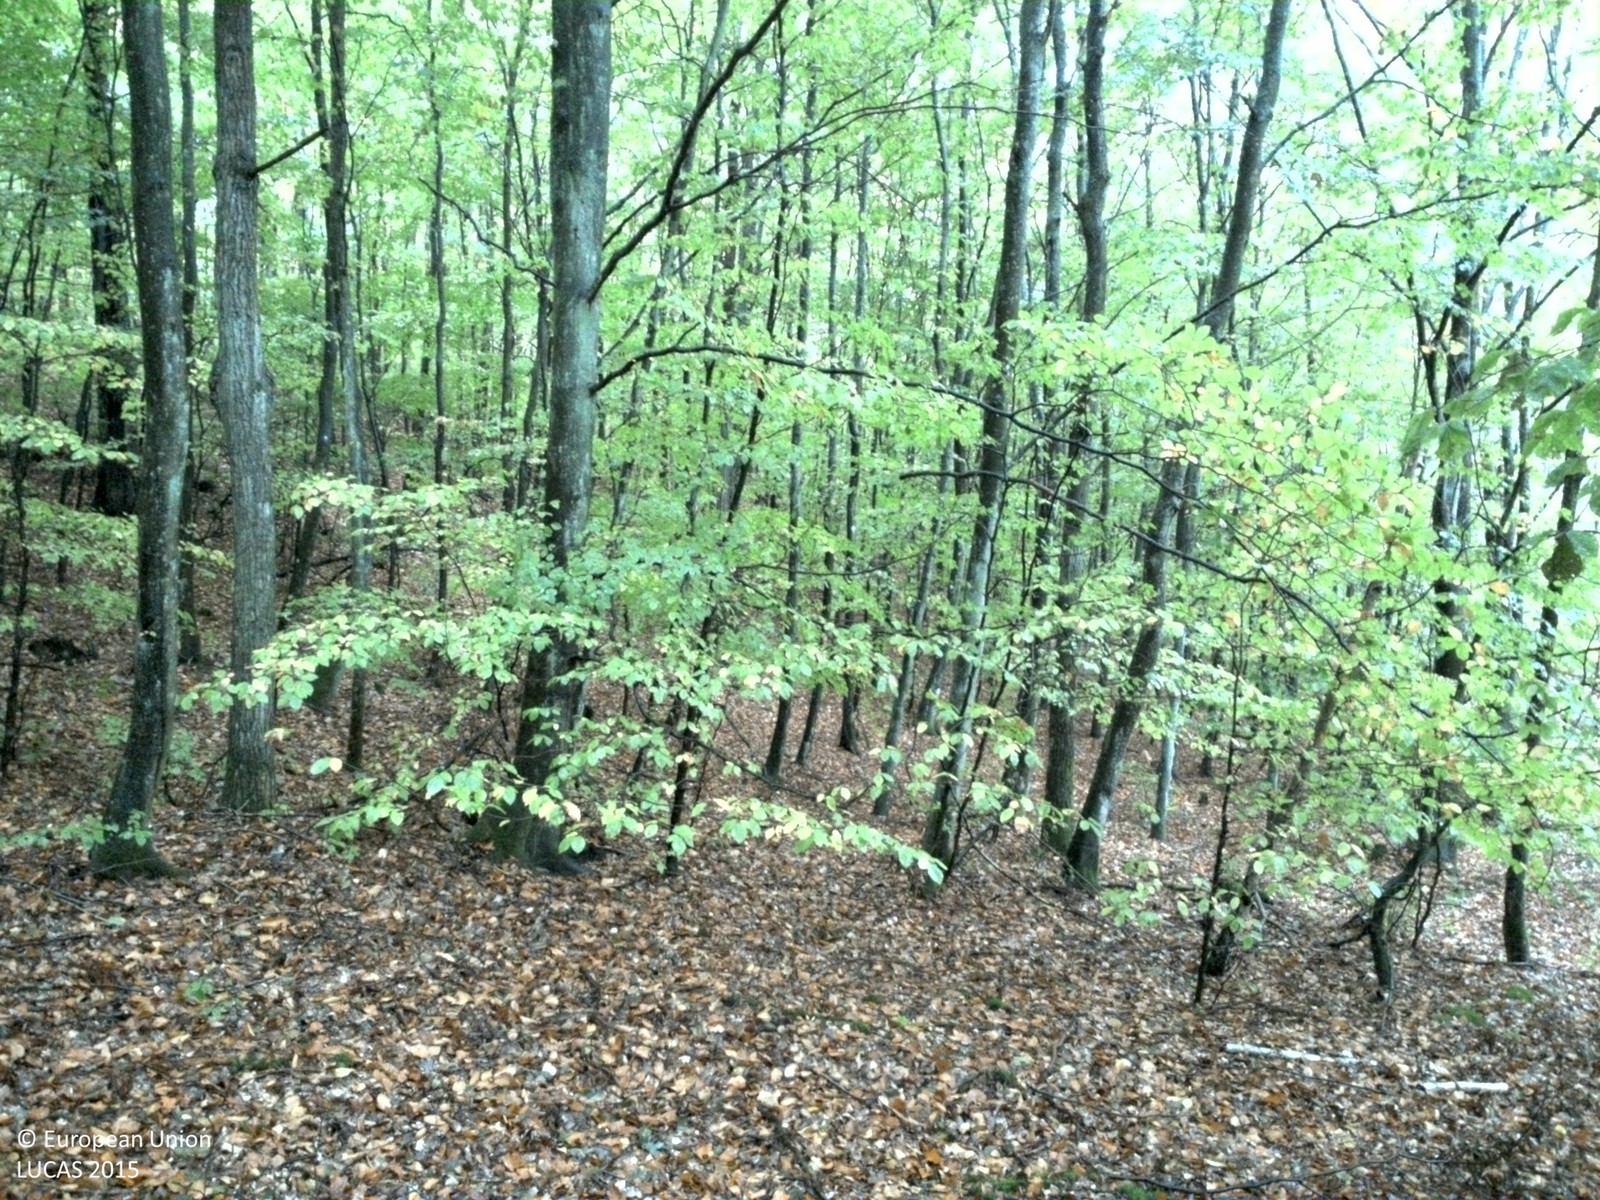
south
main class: Woodland
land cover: Broadleaved woodland
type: beech forest
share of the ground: > 75 %
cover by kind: broadleaved forest trees 80 %, unconsolidated bare surface 15 %, shrubs 5 %
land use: Forestry
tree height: > 5 m
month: October
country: SE
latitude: 55.7276
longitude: 14.0586
